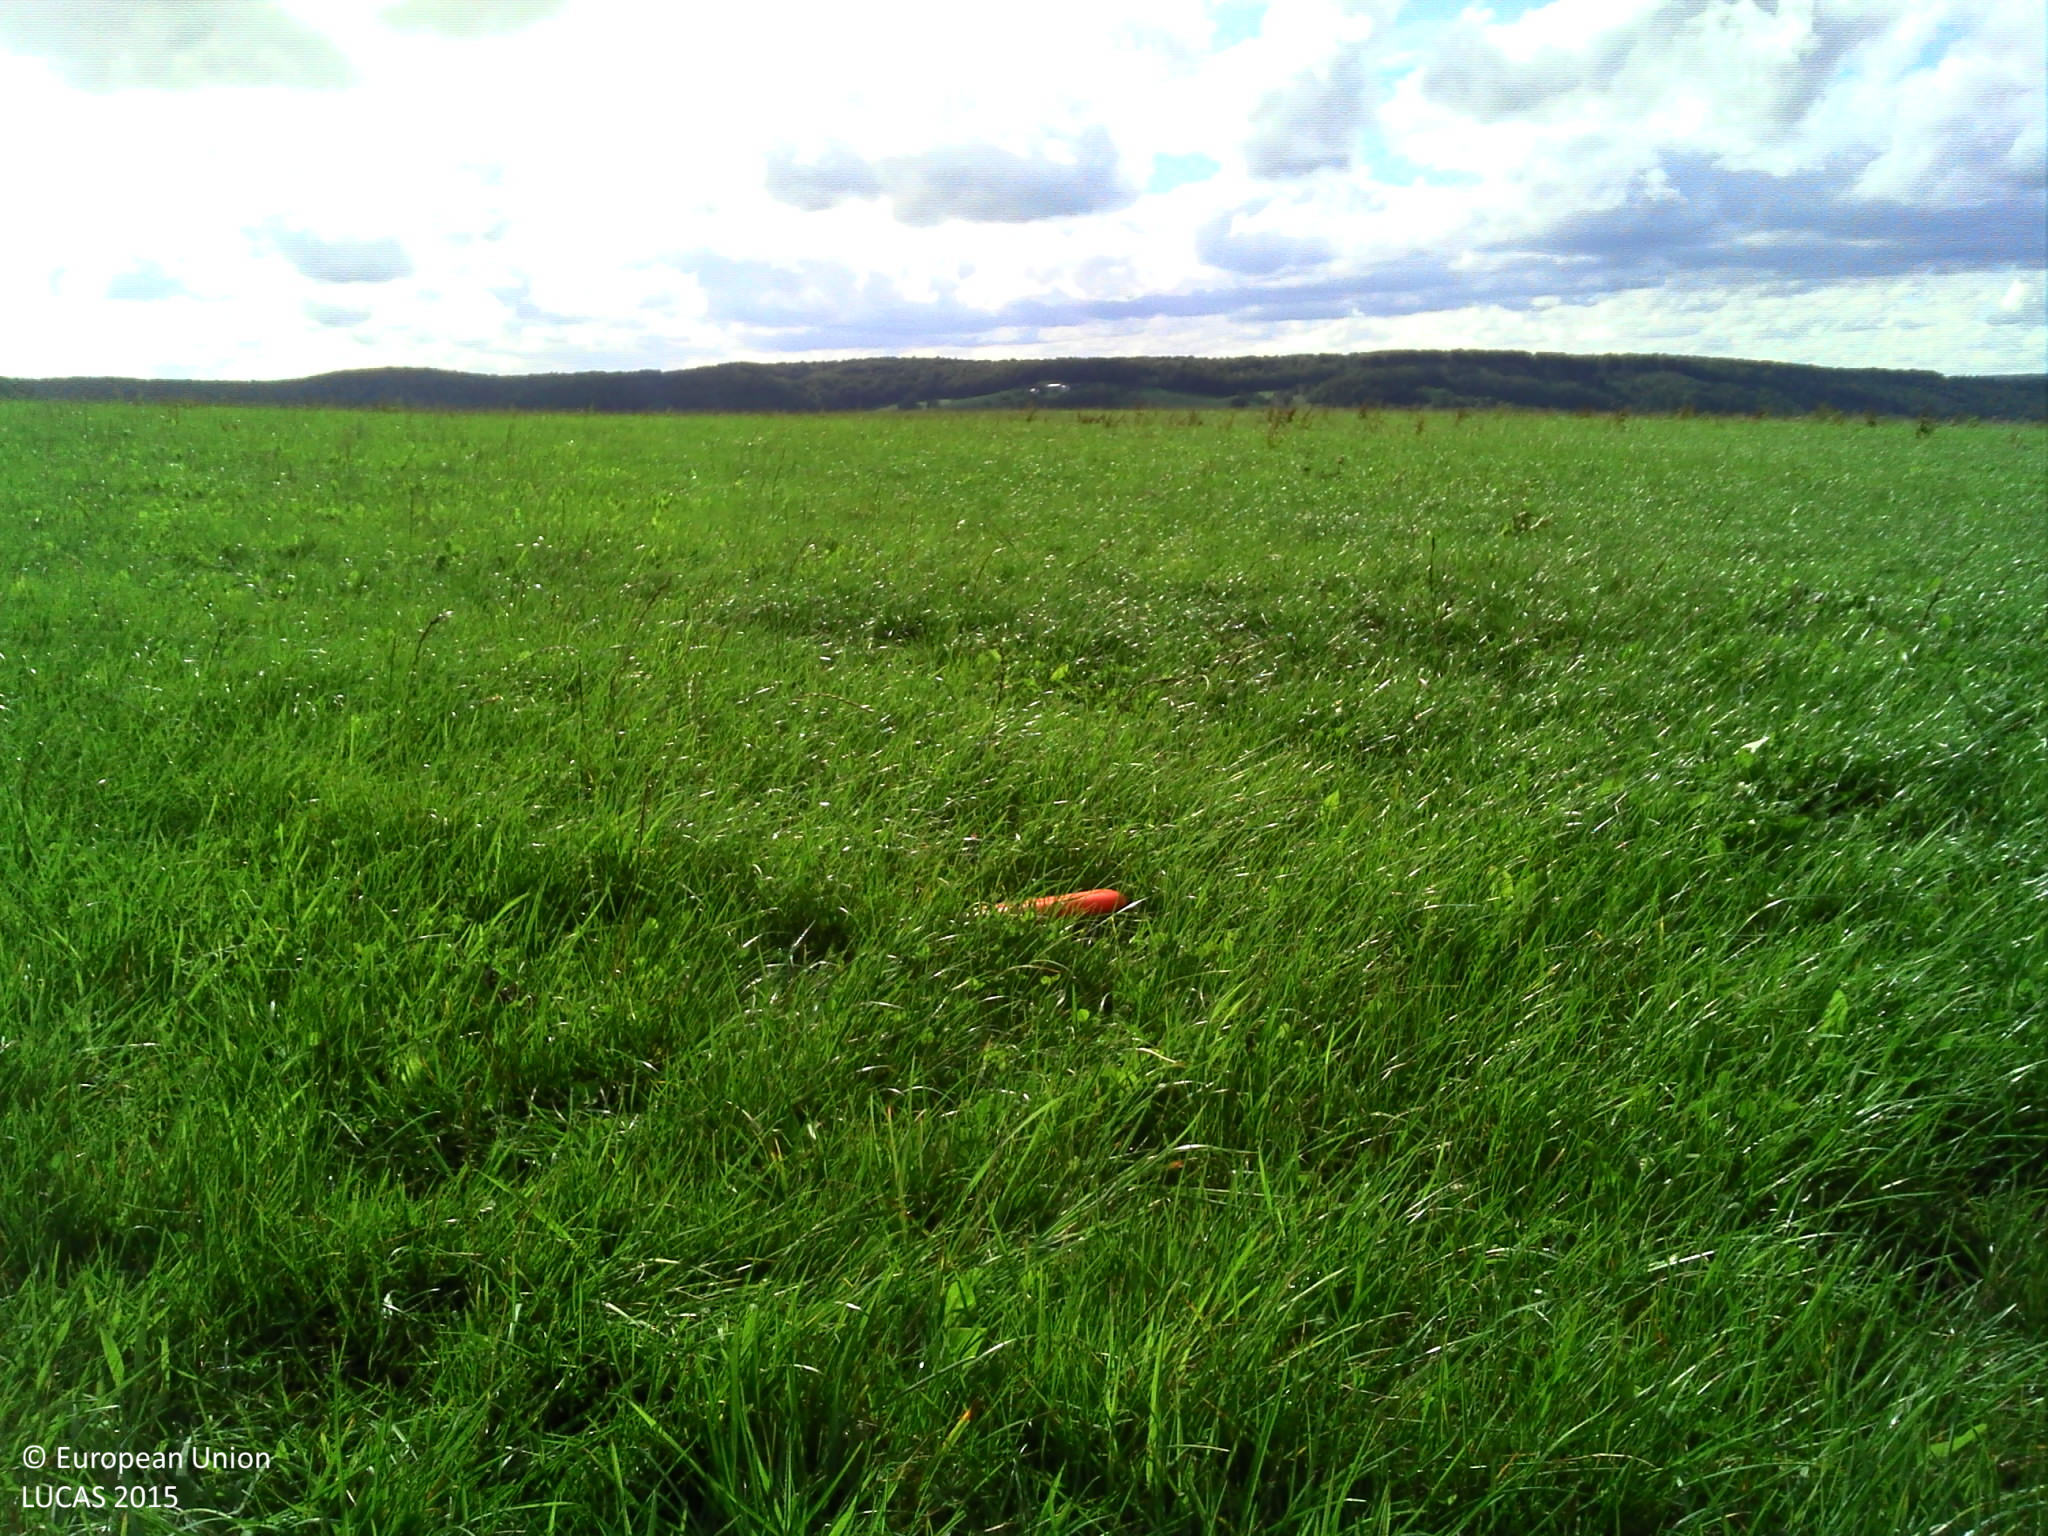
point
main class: Grassland
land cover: Grassland without tree/shrub cover
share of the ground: > 75 %
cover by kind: herbaceous plants 100 %
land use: Agriculture (excluding fallow land and kitchen gardens)
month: September
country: LU
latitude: 49.7872
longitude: 6.4578
